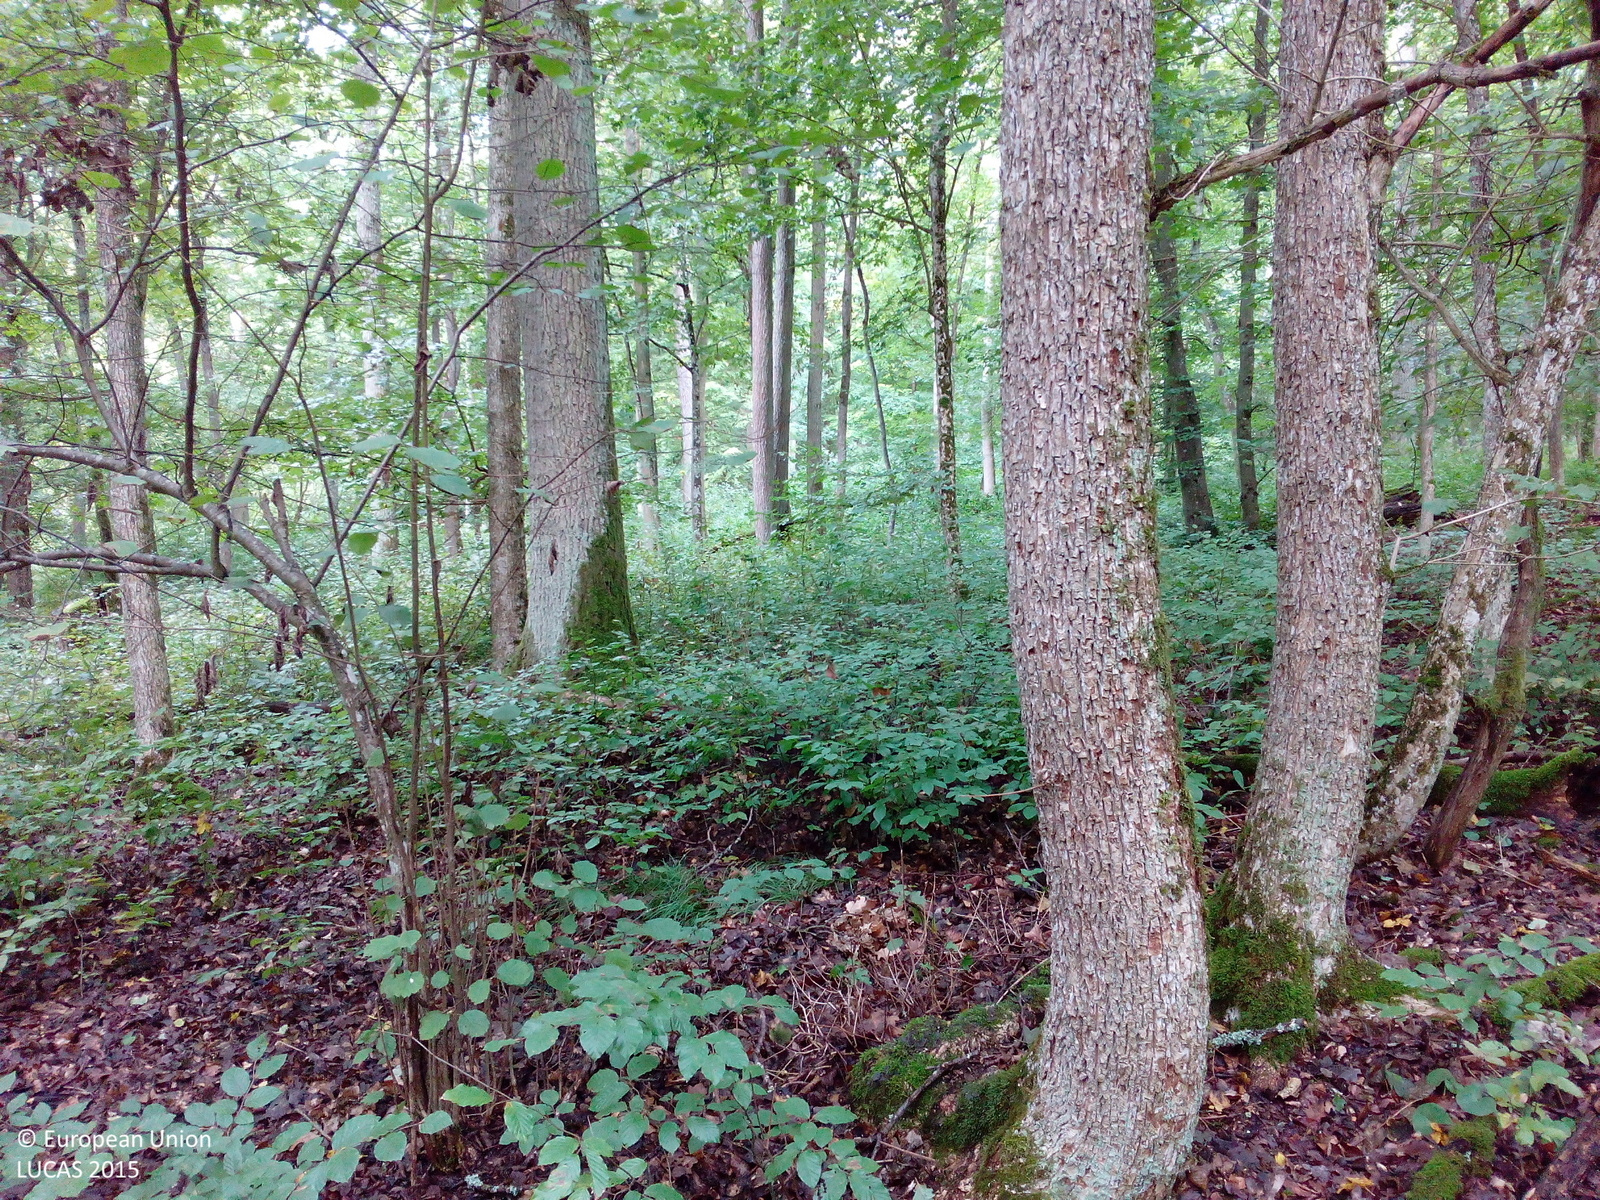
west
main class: Woodland
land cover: Broadleaved woodland
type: acidophilous oak and oak-birch forest
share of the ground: > 75 %
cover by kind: broadleaved forest trees 90 %, shrubs 5 %, unconsolidated bare surface 5 %
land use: Forestry
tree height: > 5 m
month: September
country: DE
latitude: 50.0044
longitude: 9.9024
